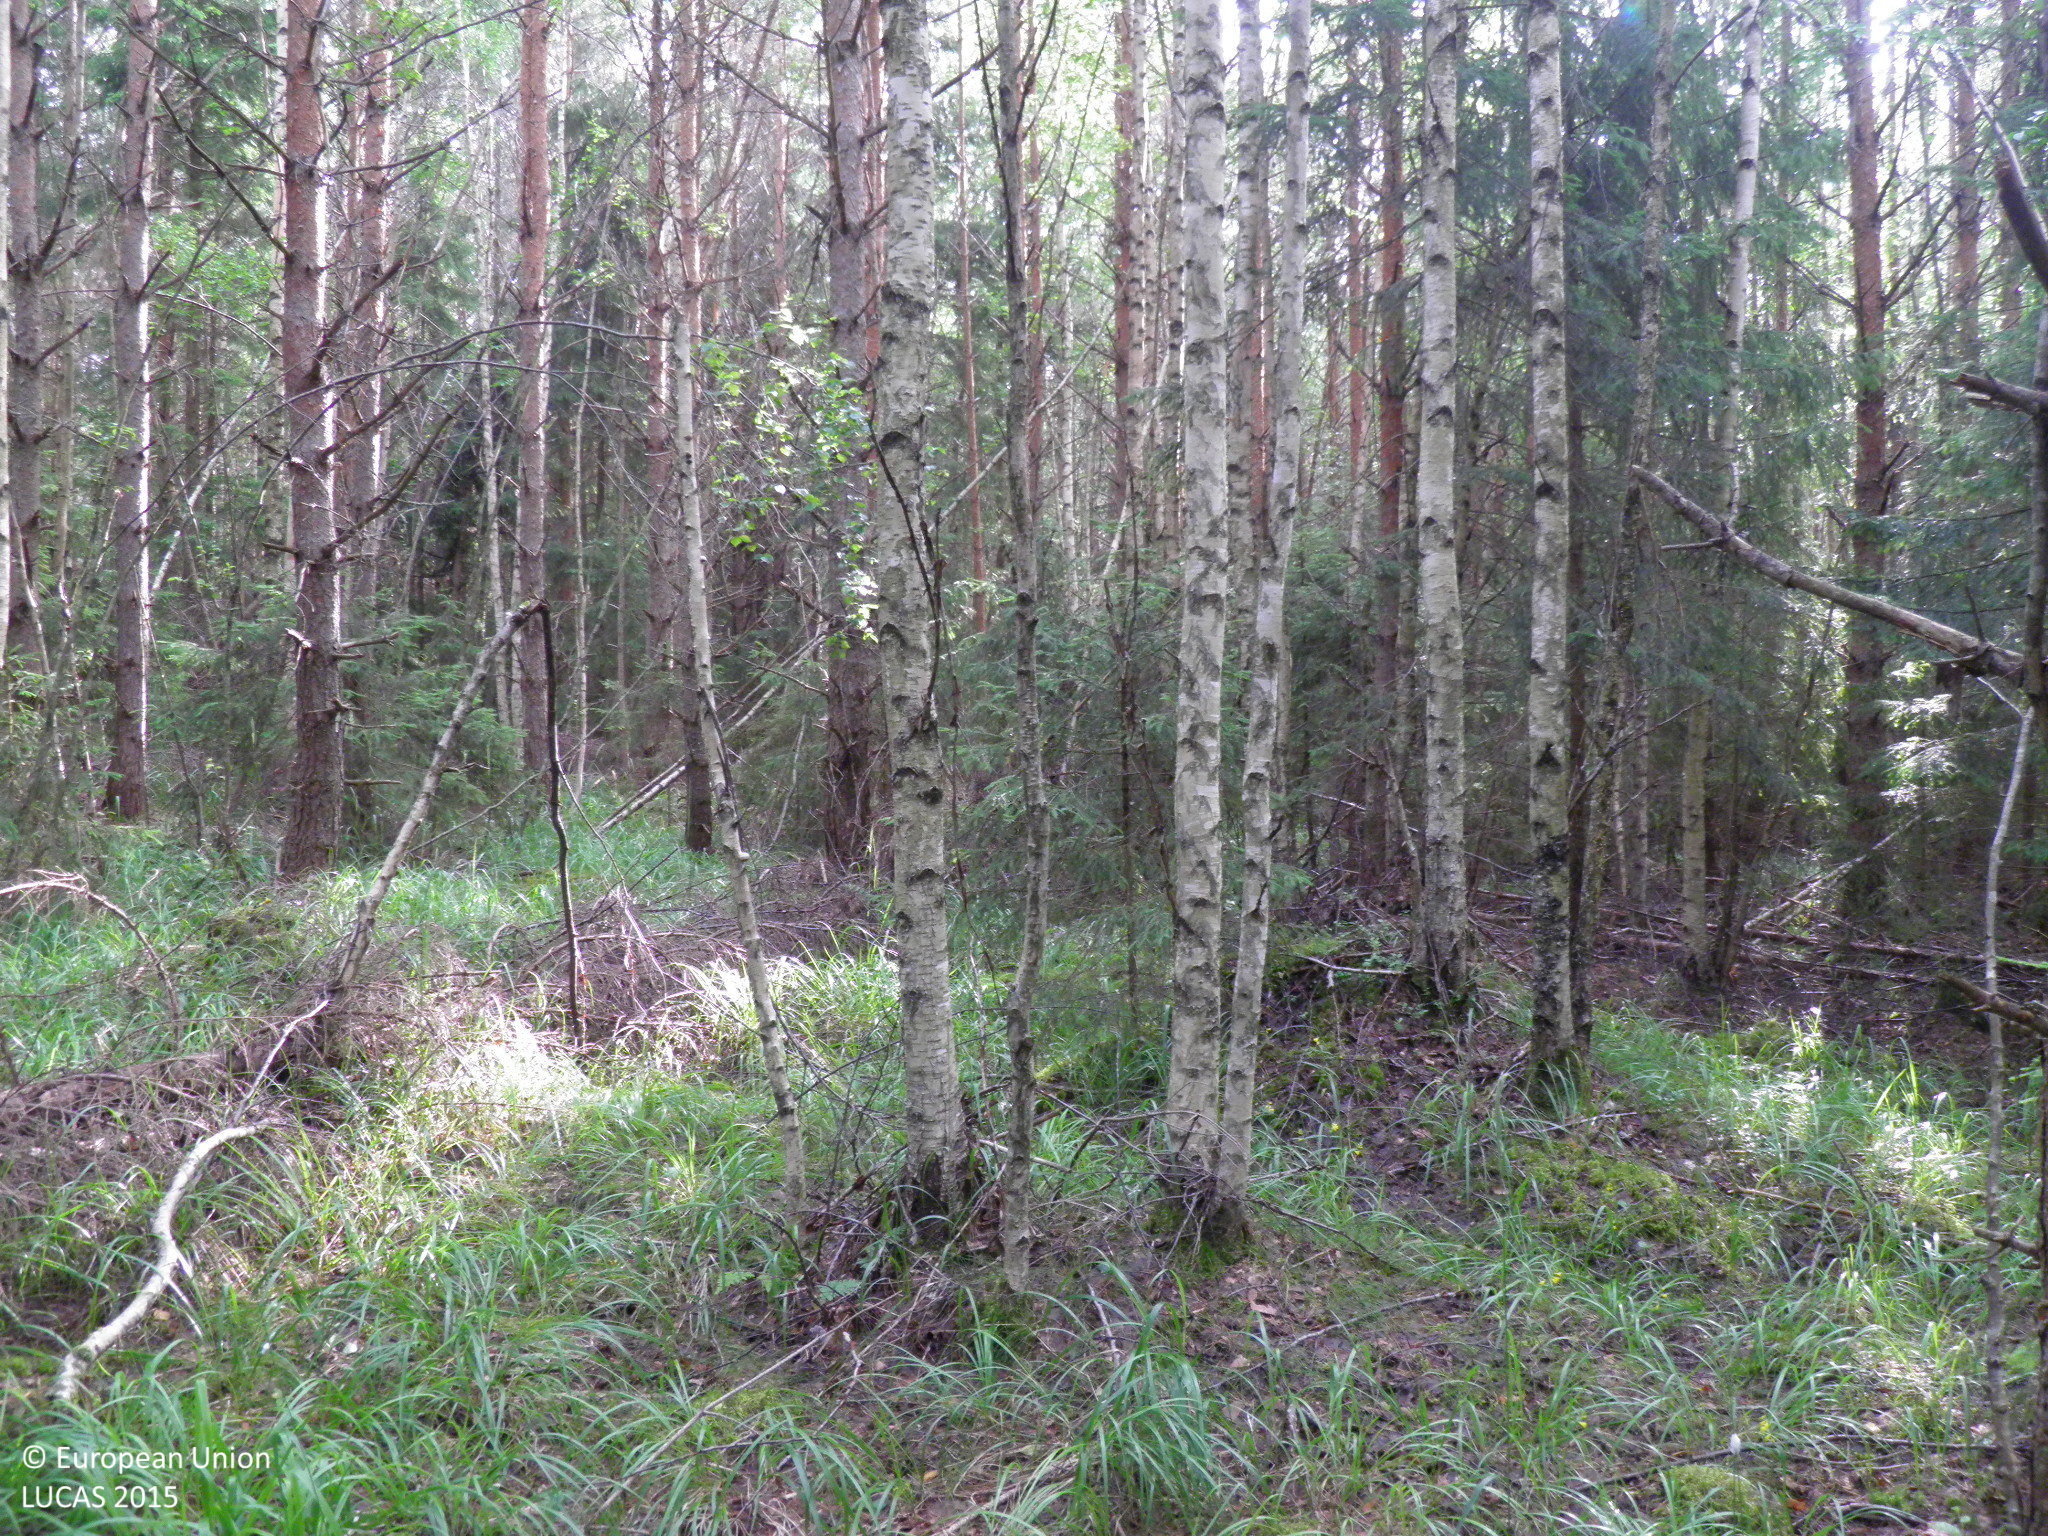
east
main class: Woodland
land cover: Pine dominated mixed woodland
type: hemiboreal forest and nemoral coniferous forest and mixed broadleaved-coniferous forest
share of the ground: > 75 %
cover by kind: broadleaved forest trees 50 %, coniferous forest trees 40 %, herbaceous plants 5 %, unconsolidated bare surface 5 %
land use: Semi-natural and natural areas not in use
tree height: > 5 m
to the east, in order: Pine dominated mixed woodland; Grass margins; Ditches and canals; Grass margins; Paved roads, cycling and walking lanes; Grass margins; Ditches and canals; Grass margins; Pine dominated mixed woodland
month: July
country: FI
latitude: 60.7229
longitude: 22.4416
